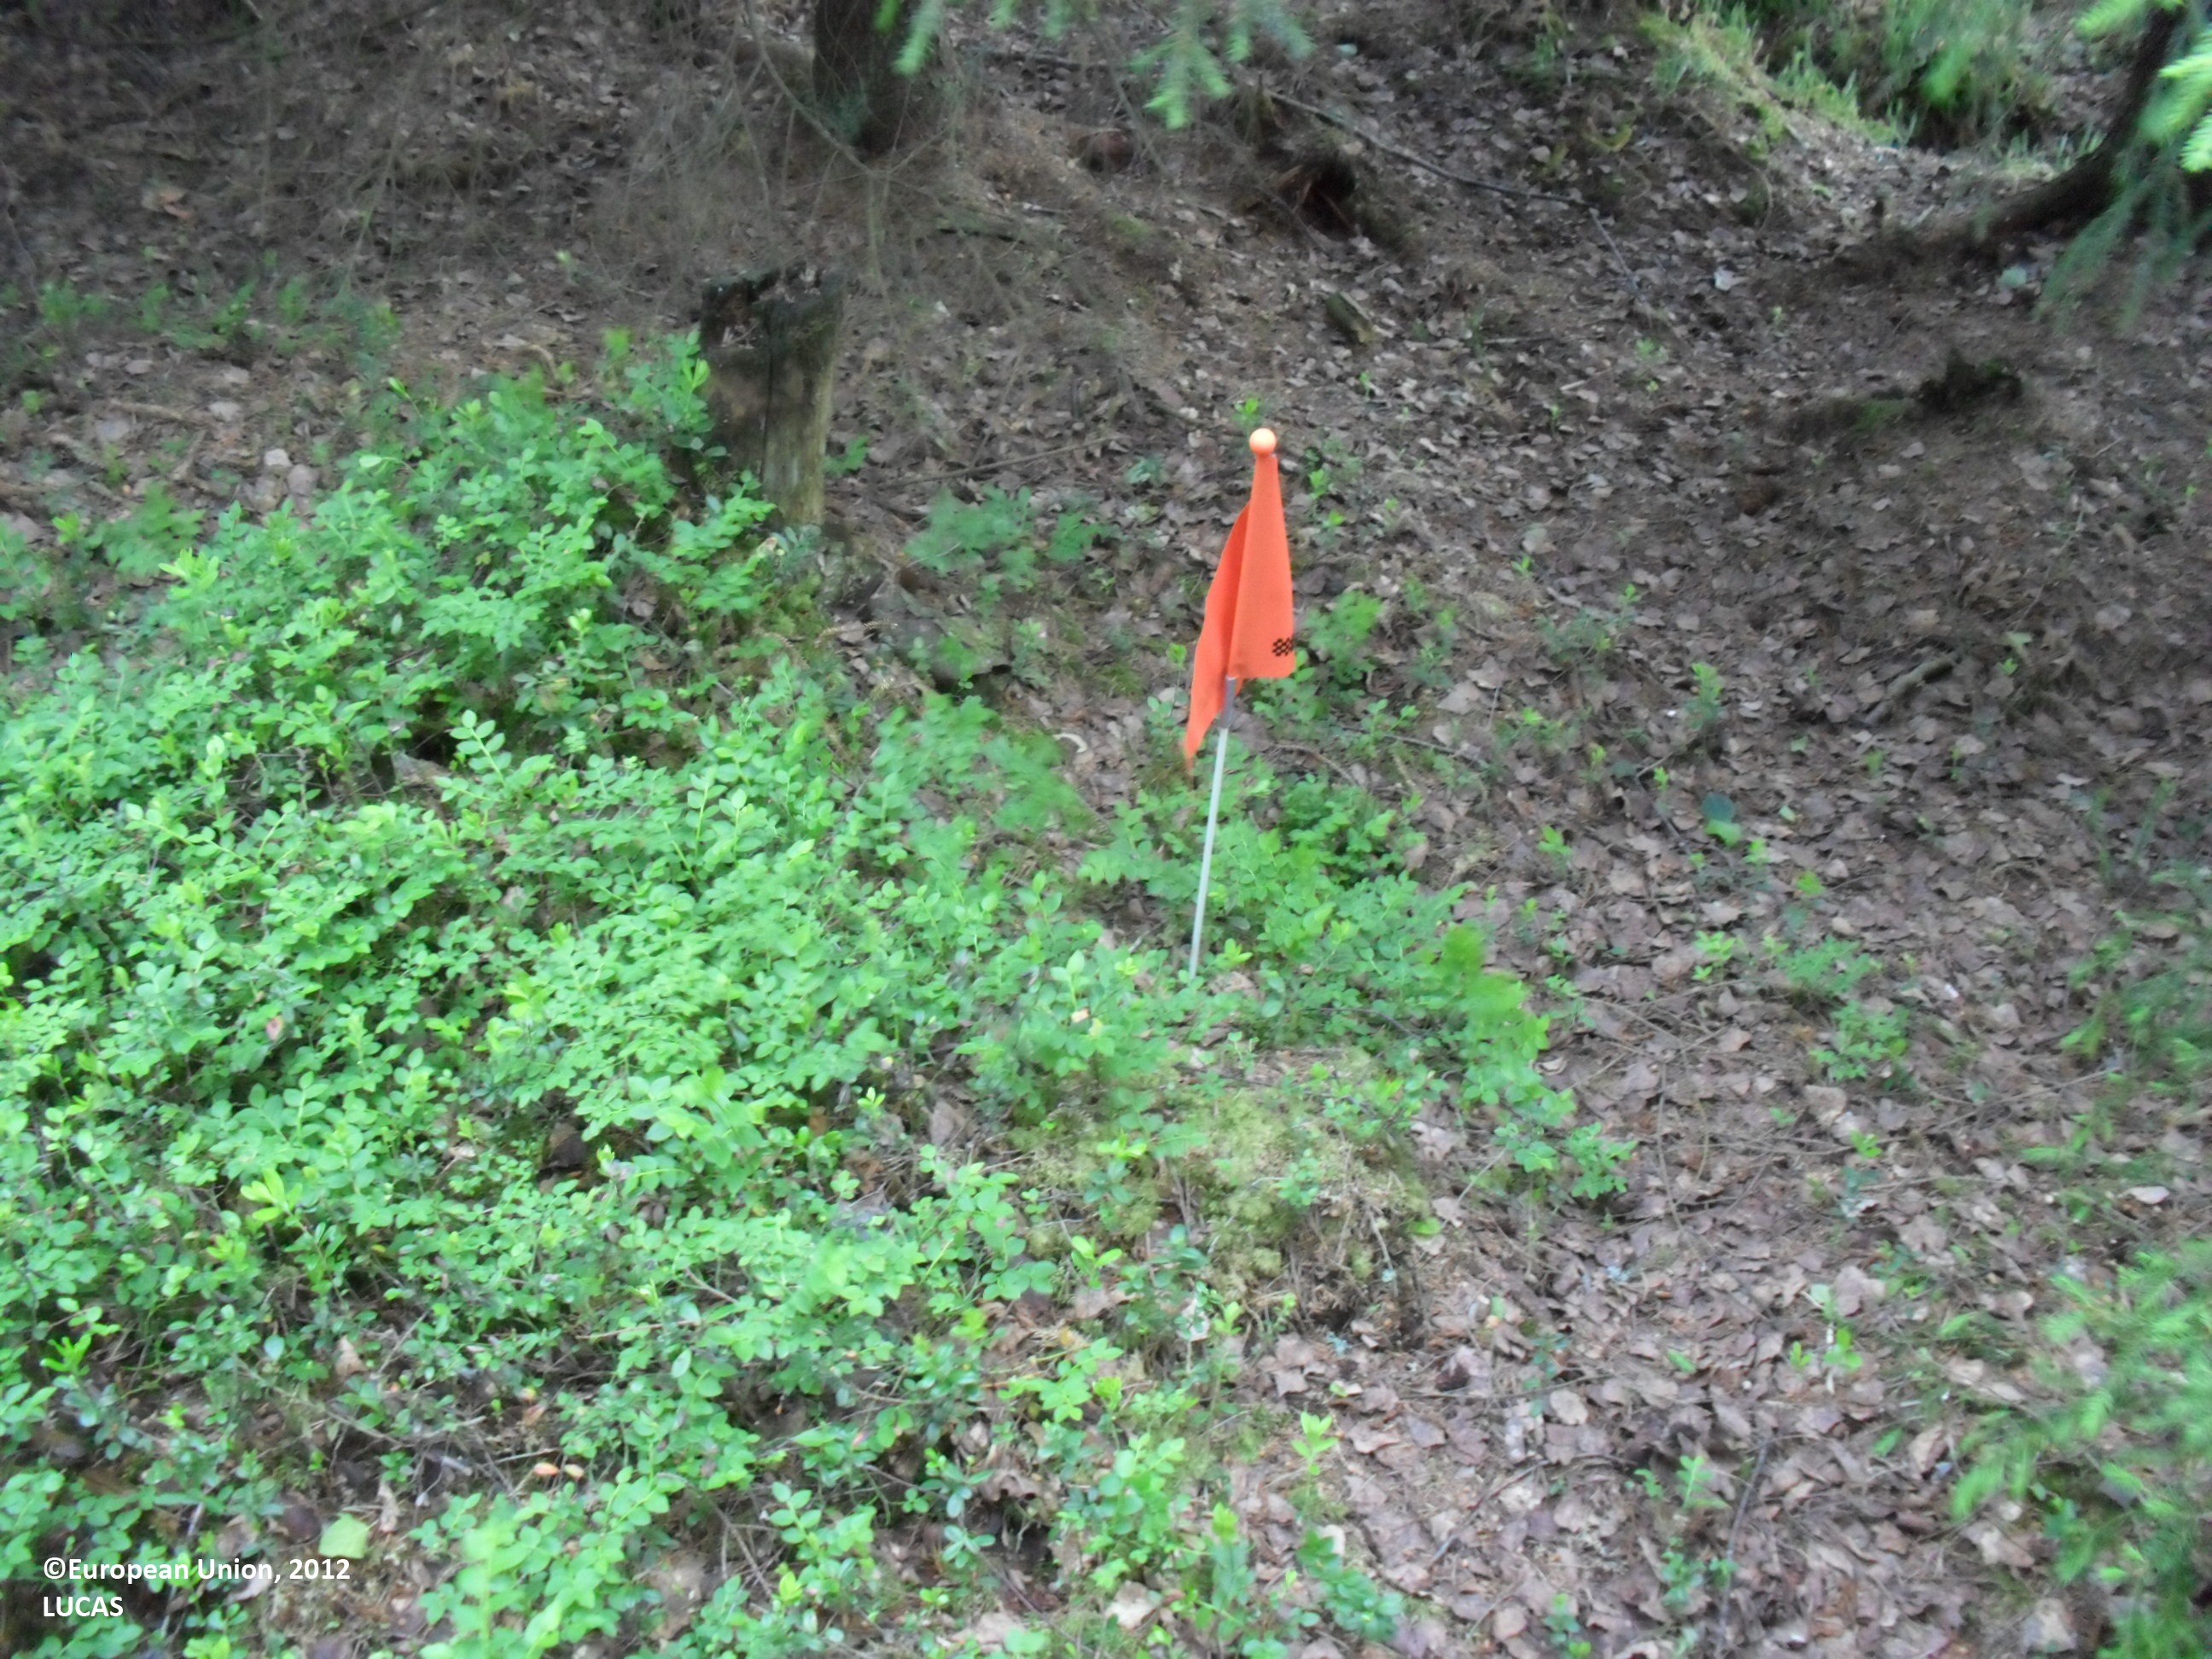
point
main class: Woodland
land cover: Spruce dominated mixed woodland
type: boreal forest
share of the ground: 50 - 75 %
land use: Forestry
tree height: > 5 m
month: June
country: FI
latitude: 63.0702
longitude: 23.0216
